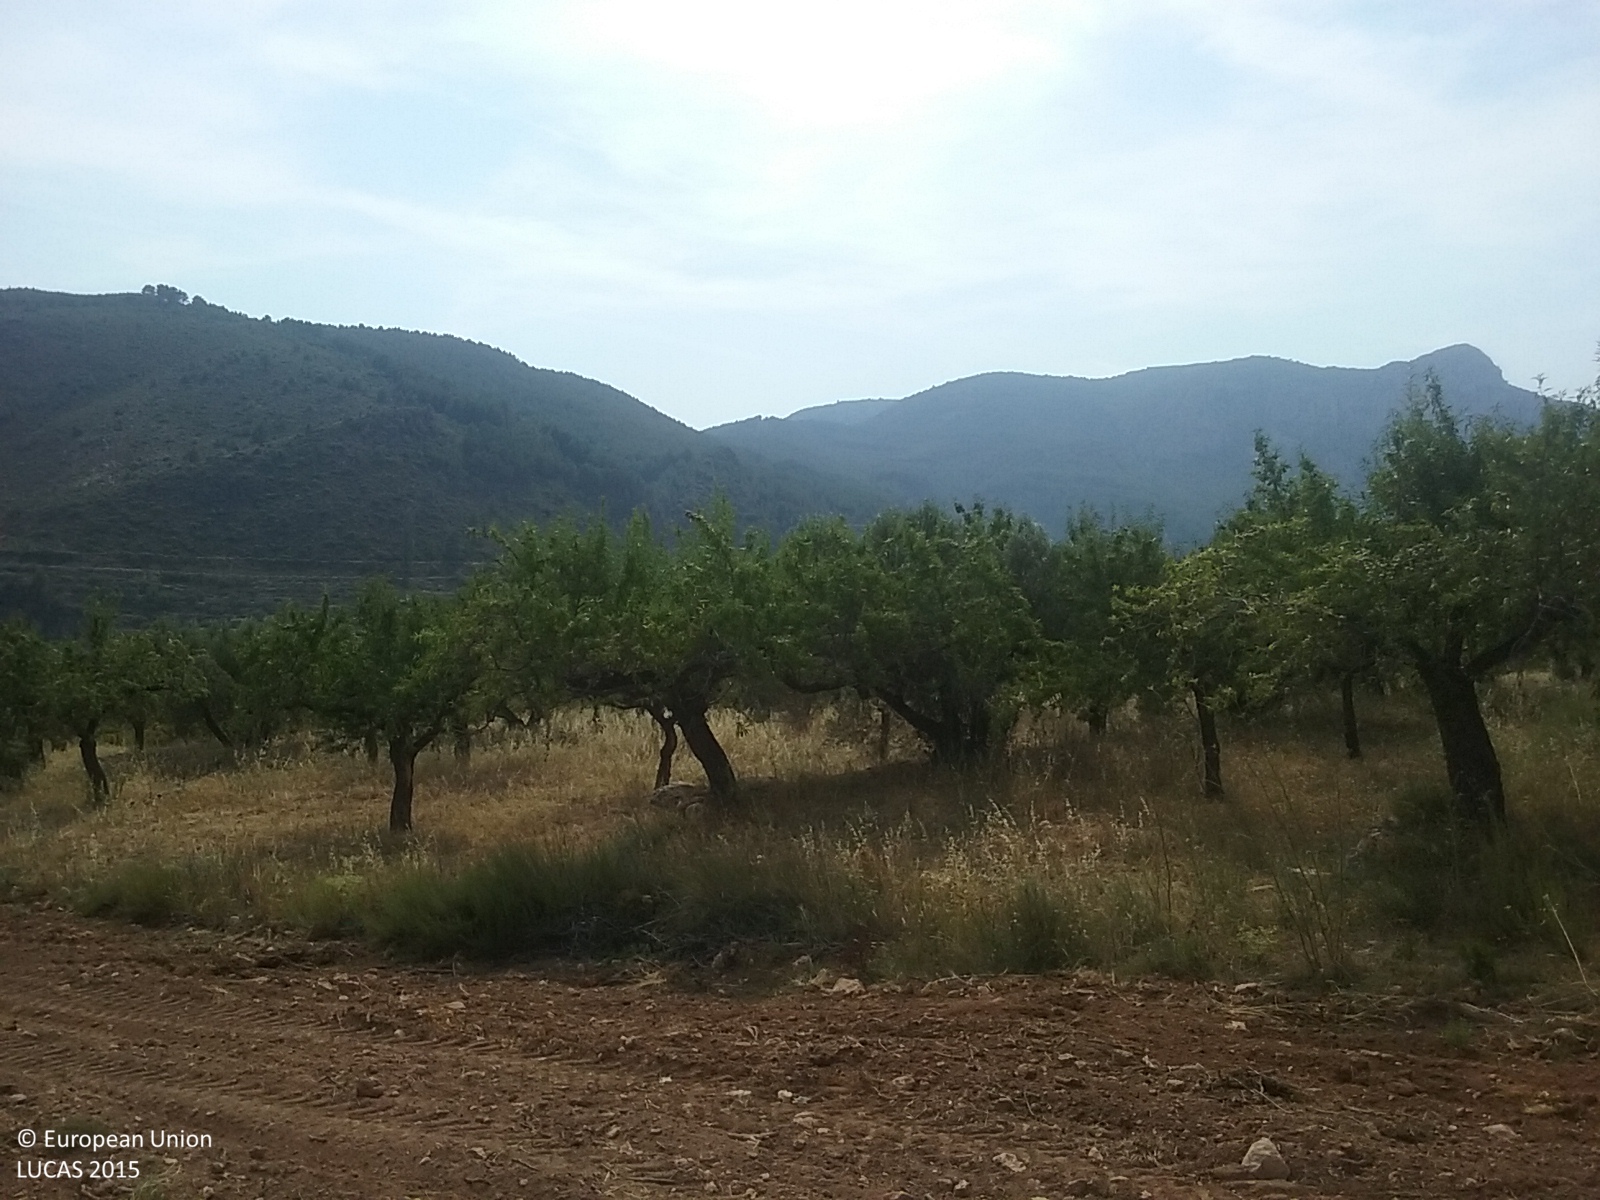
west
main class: Cropland
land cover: Nuts trees
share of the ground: 10 - 25 %
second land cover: Spontaneously vegetated surfaces
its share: 10 - 25 %
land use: Agriculture (excluding fallow land and kitchen gardens)
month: July
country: ES
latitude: 39.9166
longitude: -0.7083
